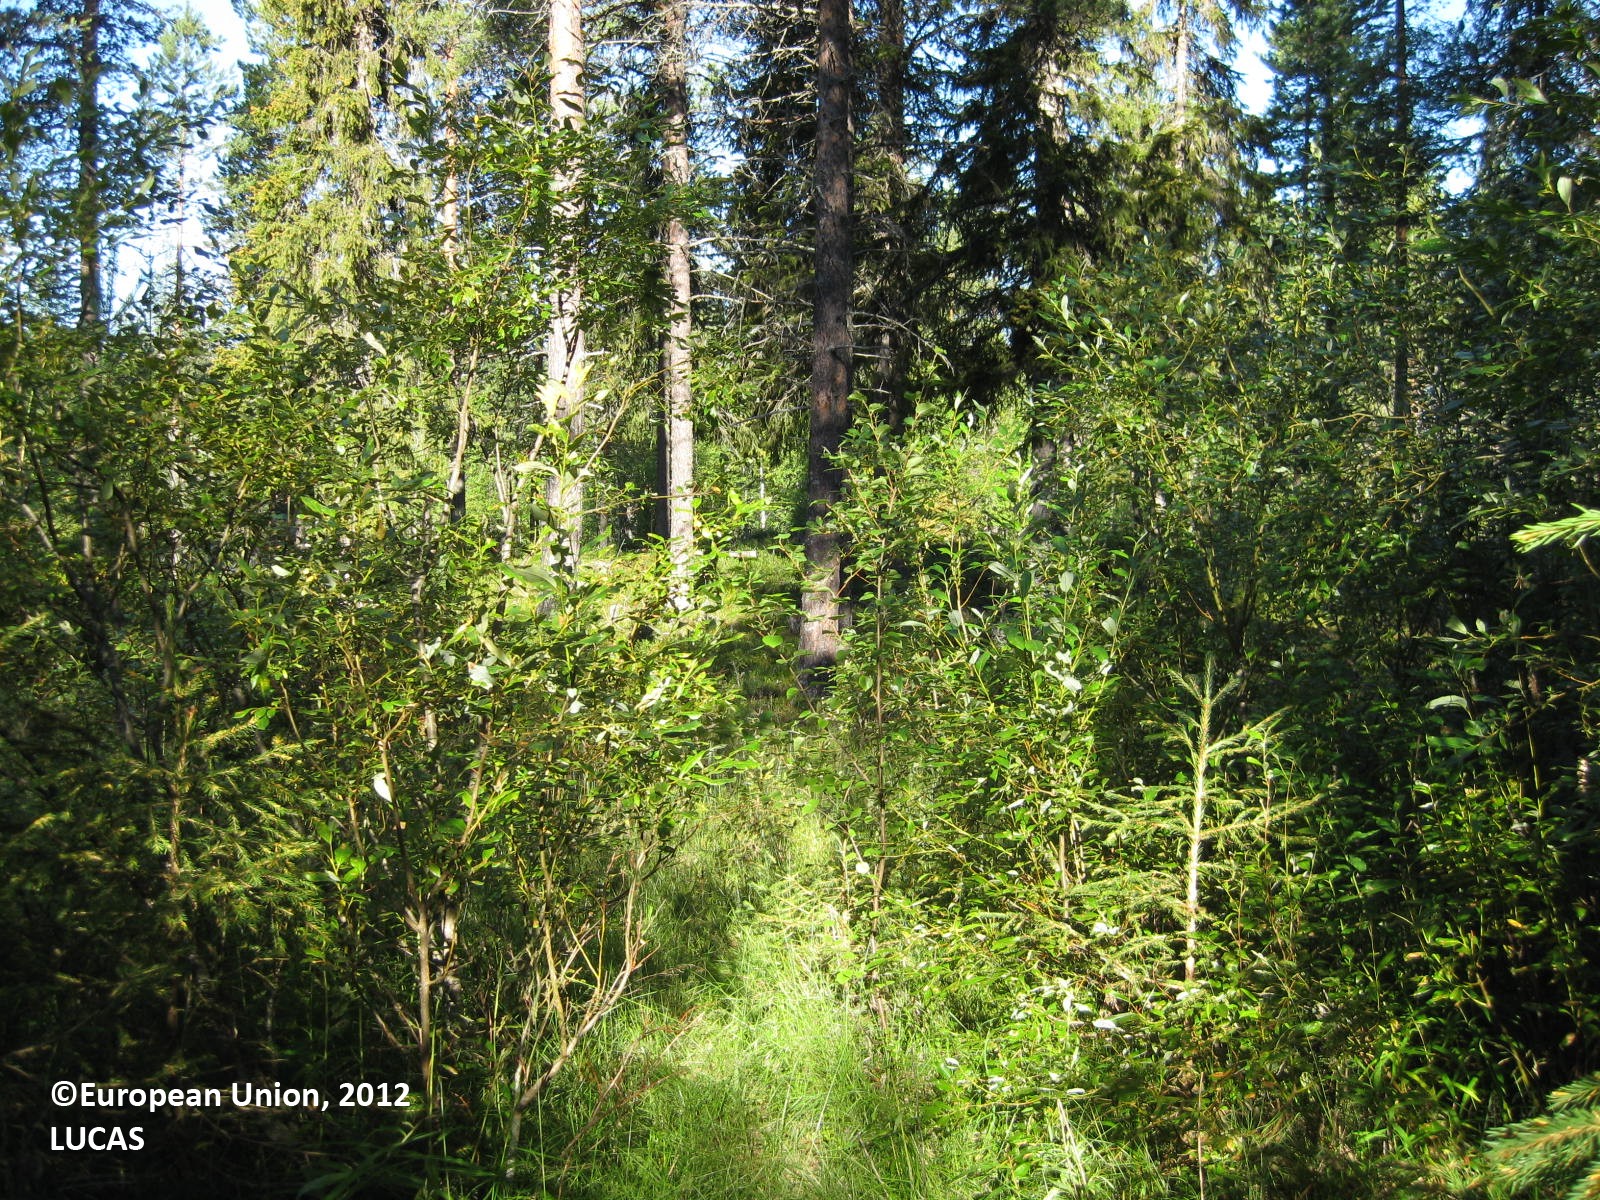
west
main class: Woodland
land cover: Other coniferous woodland
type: boreal forest
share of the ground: > 75 %
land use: Forestry
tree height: > 5 m
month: August
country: FI
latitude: 66.5398
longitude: 28.5836
